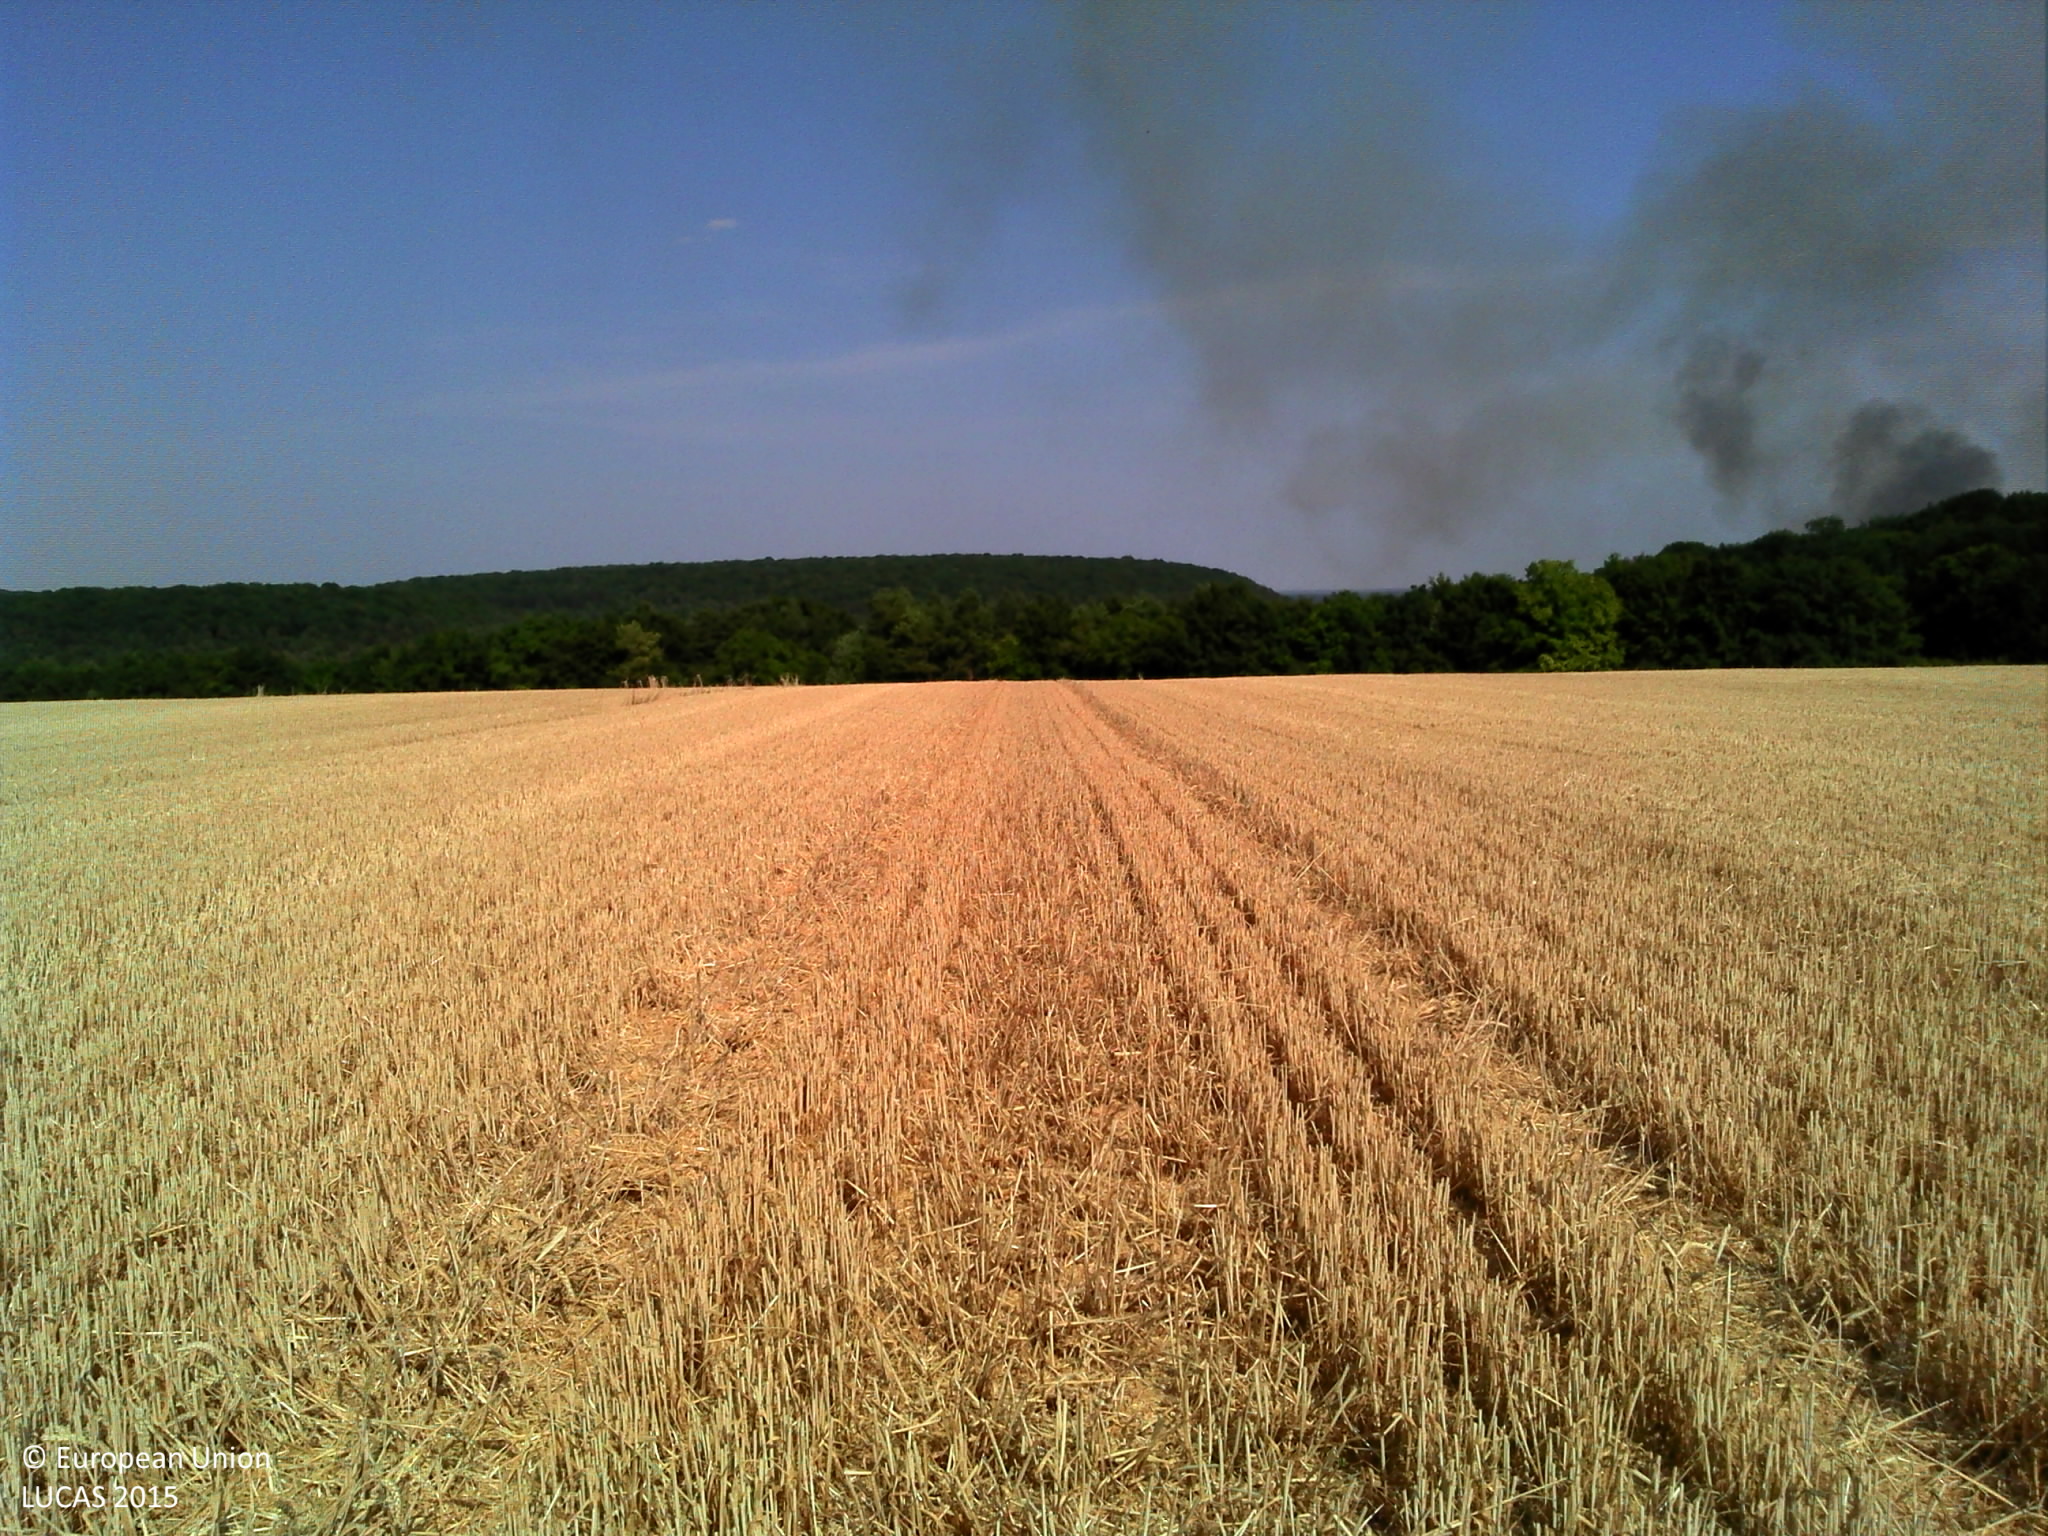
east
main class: Cropland
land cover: Common wheat
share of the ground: 10 - 25 %
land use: Agriculture (excluding fallow land and kitchen gardens)
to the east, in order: Common wheat; Broadleaved woodland
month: July
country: FR
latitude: 47.9933
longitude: 4.8127
